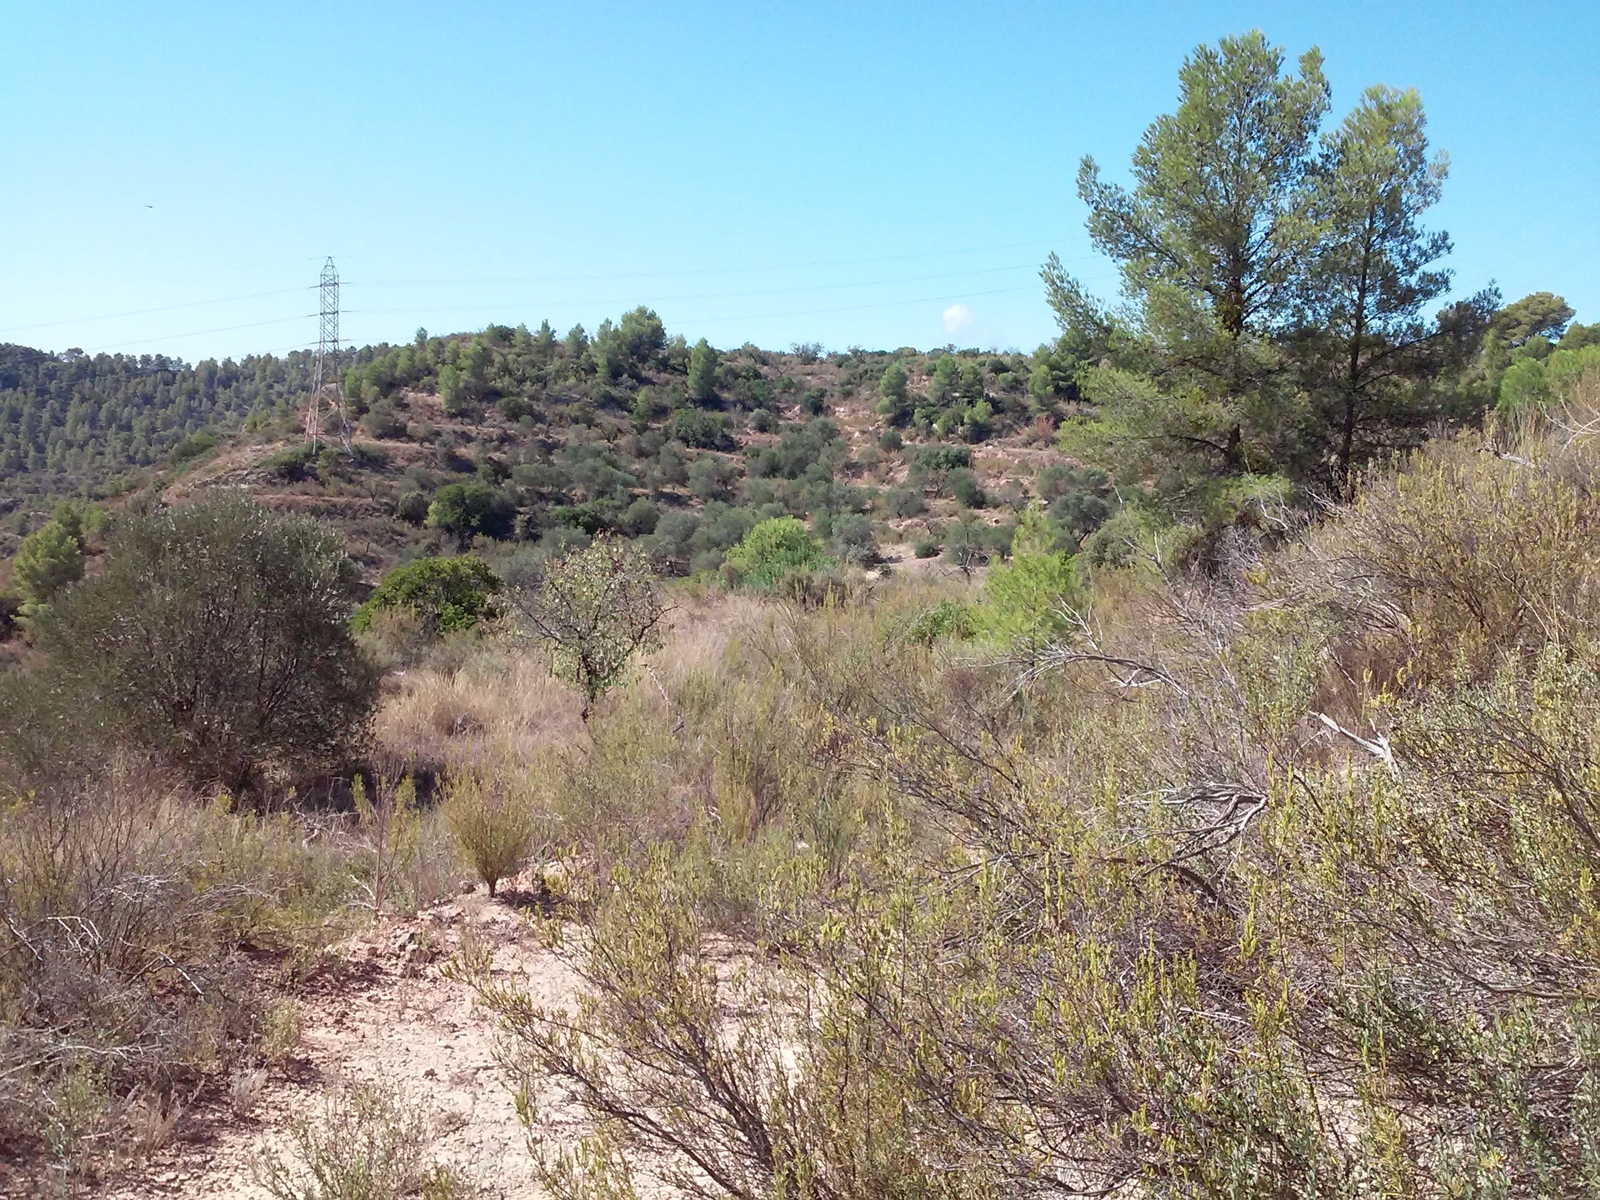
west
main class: Cropland
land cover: Nuts trees
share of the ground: 10 - 25 %
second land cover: Grassland without tree/shrub cover
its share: > 75 %
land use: Abandoned areas
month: September
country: ES
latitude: 41.2165
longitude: 0.6038
